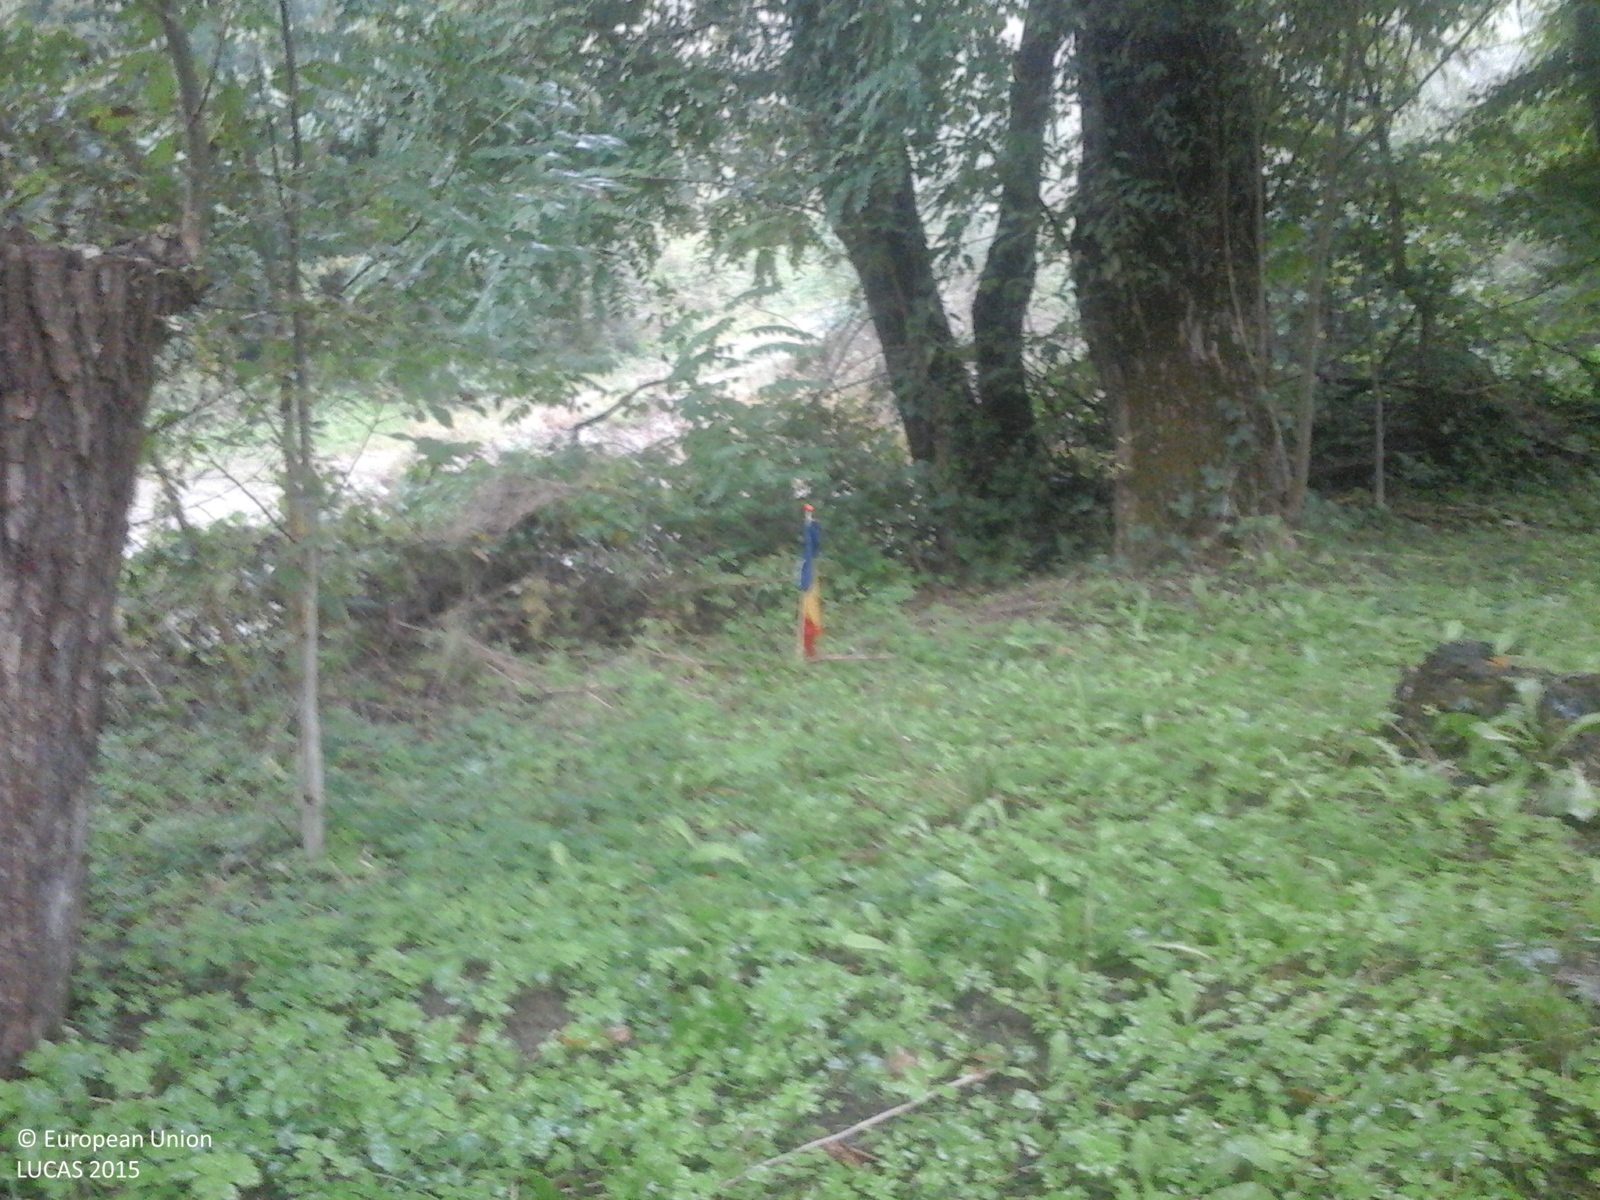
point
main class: Cropland
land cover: Nuts trees
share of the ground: > 75 %
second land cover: Grassland without tree/shrub cover
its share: < 10 %
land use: Agriculture (excluding fallow land and kitchen gardens)
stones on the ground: < 10 %
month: October
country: RO
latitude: 46.3510
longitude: 23.6225
